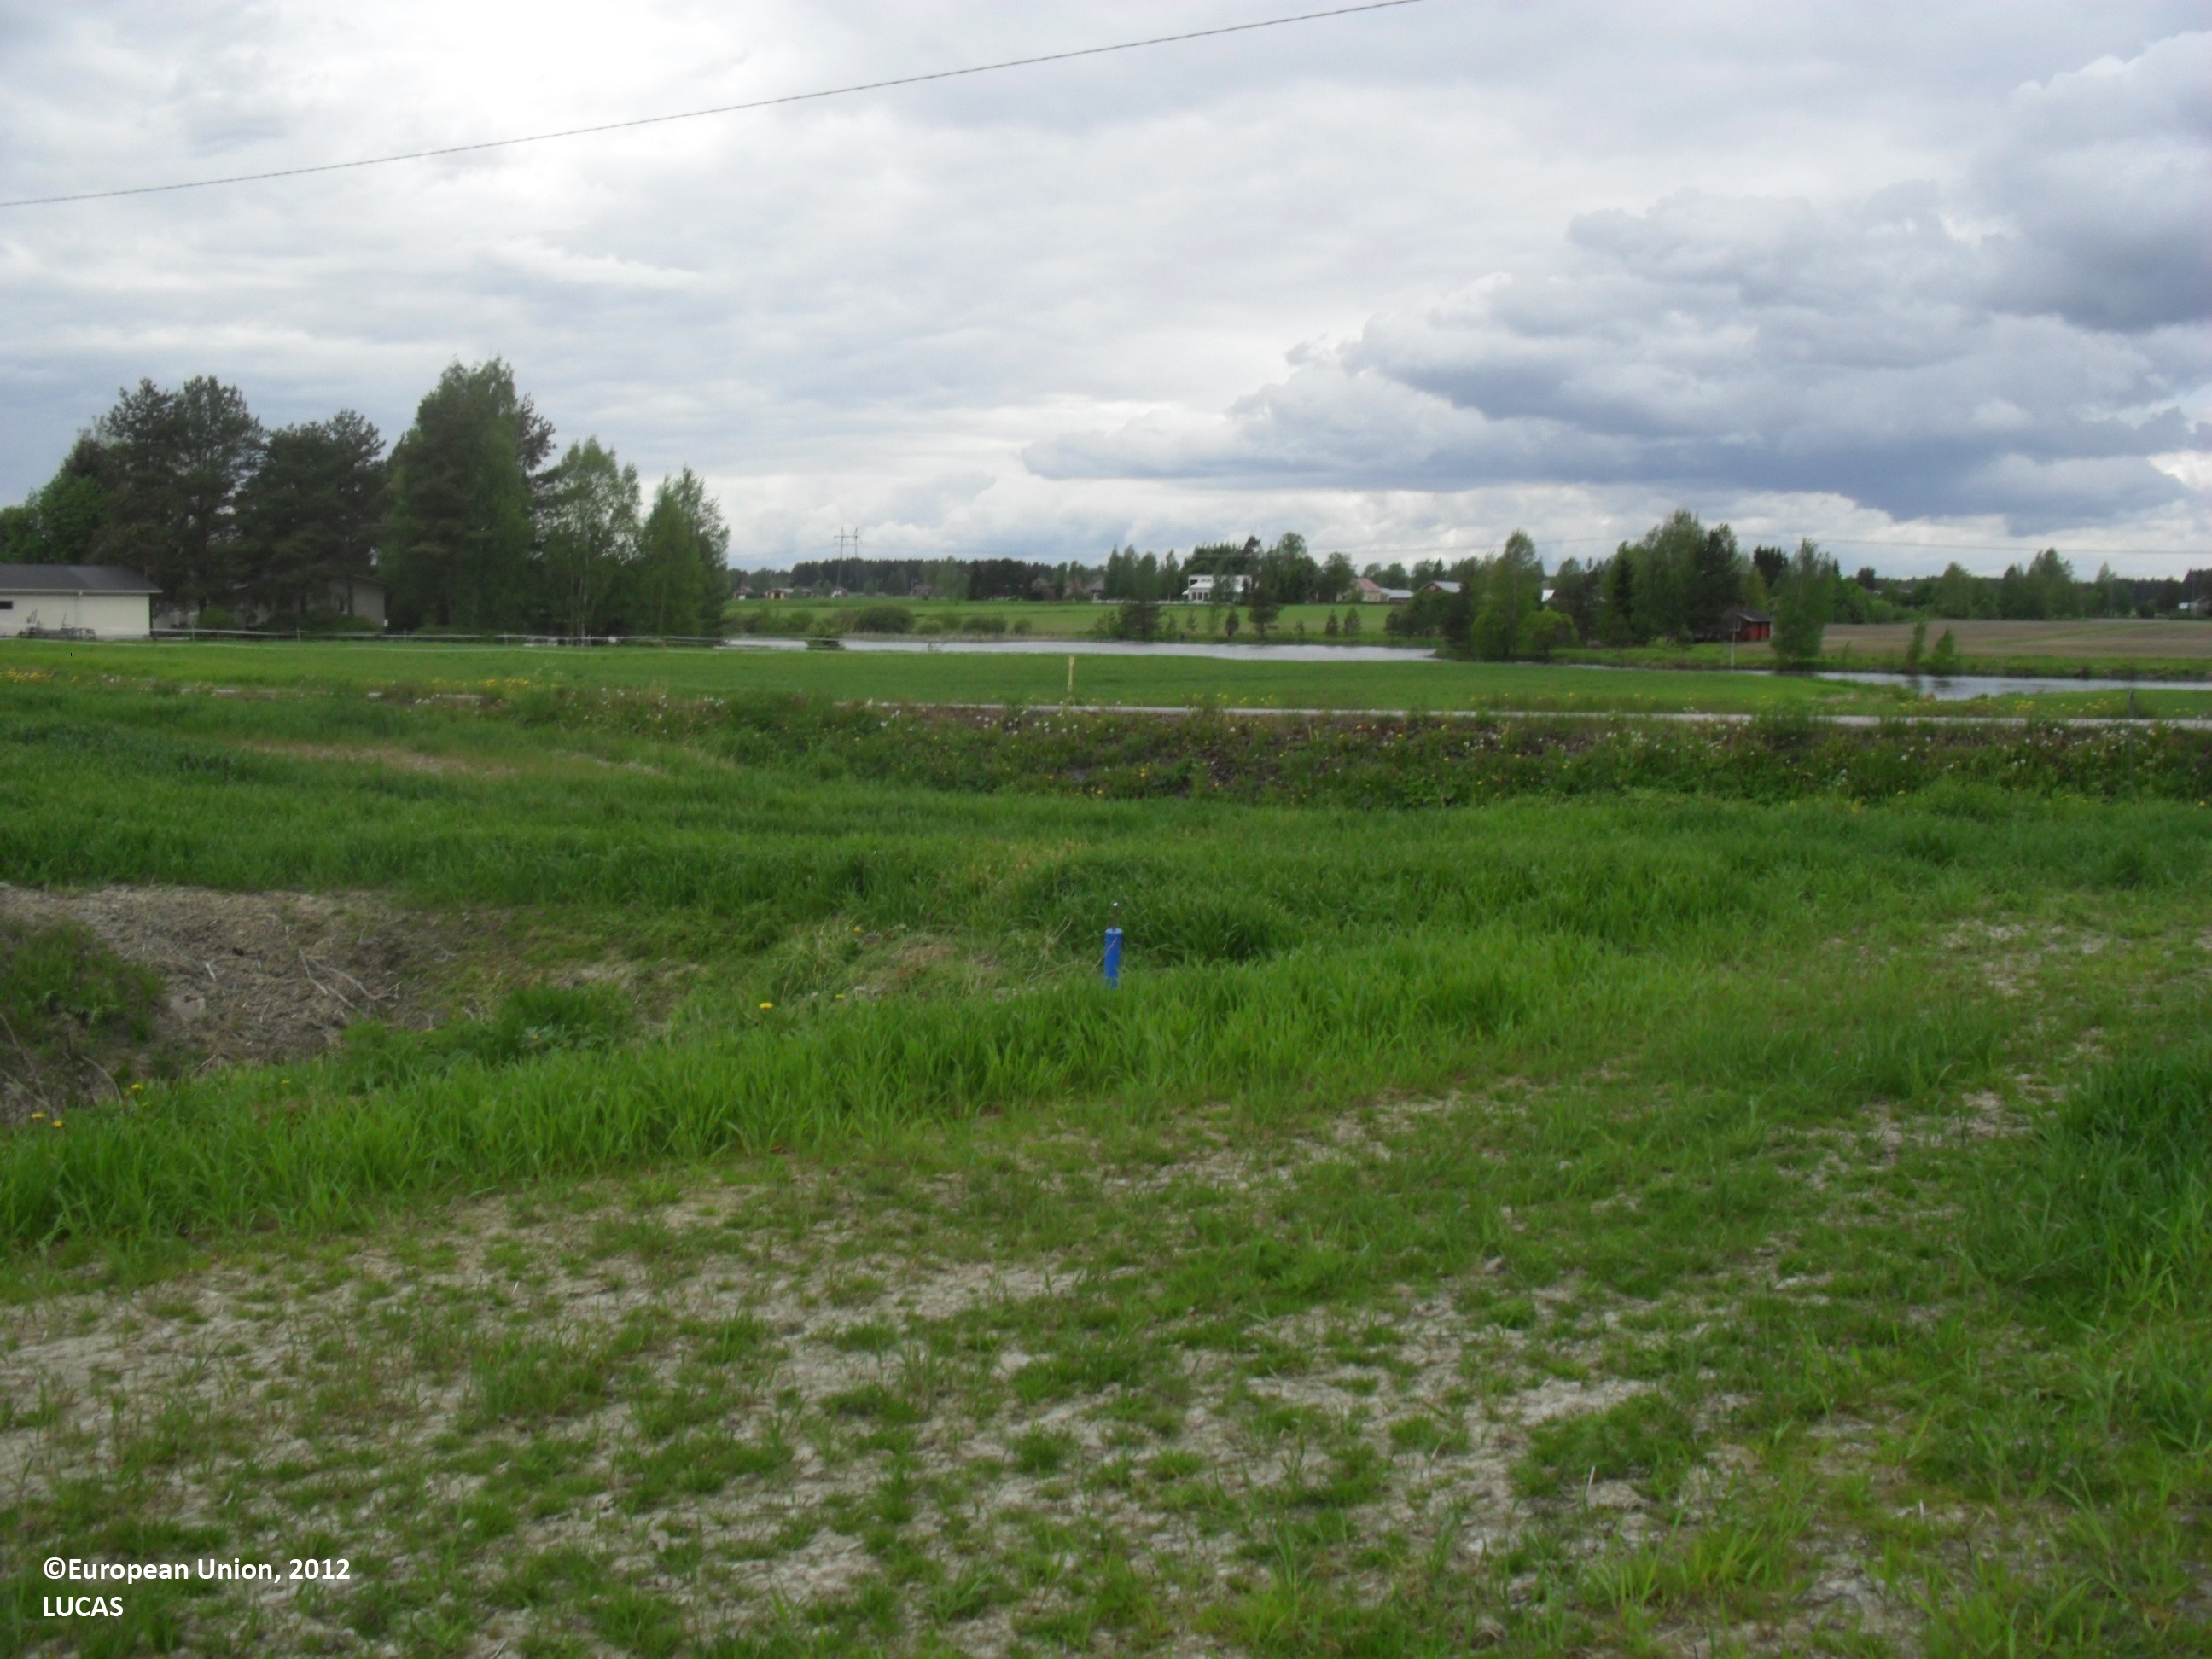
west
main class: Cropland
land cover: Common wheat
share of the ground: 50 - 75 %
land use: Agriculture (excluding fallow land and kitchen gardens)
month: June
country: FI
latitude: 62.8582
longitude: 22.9286
